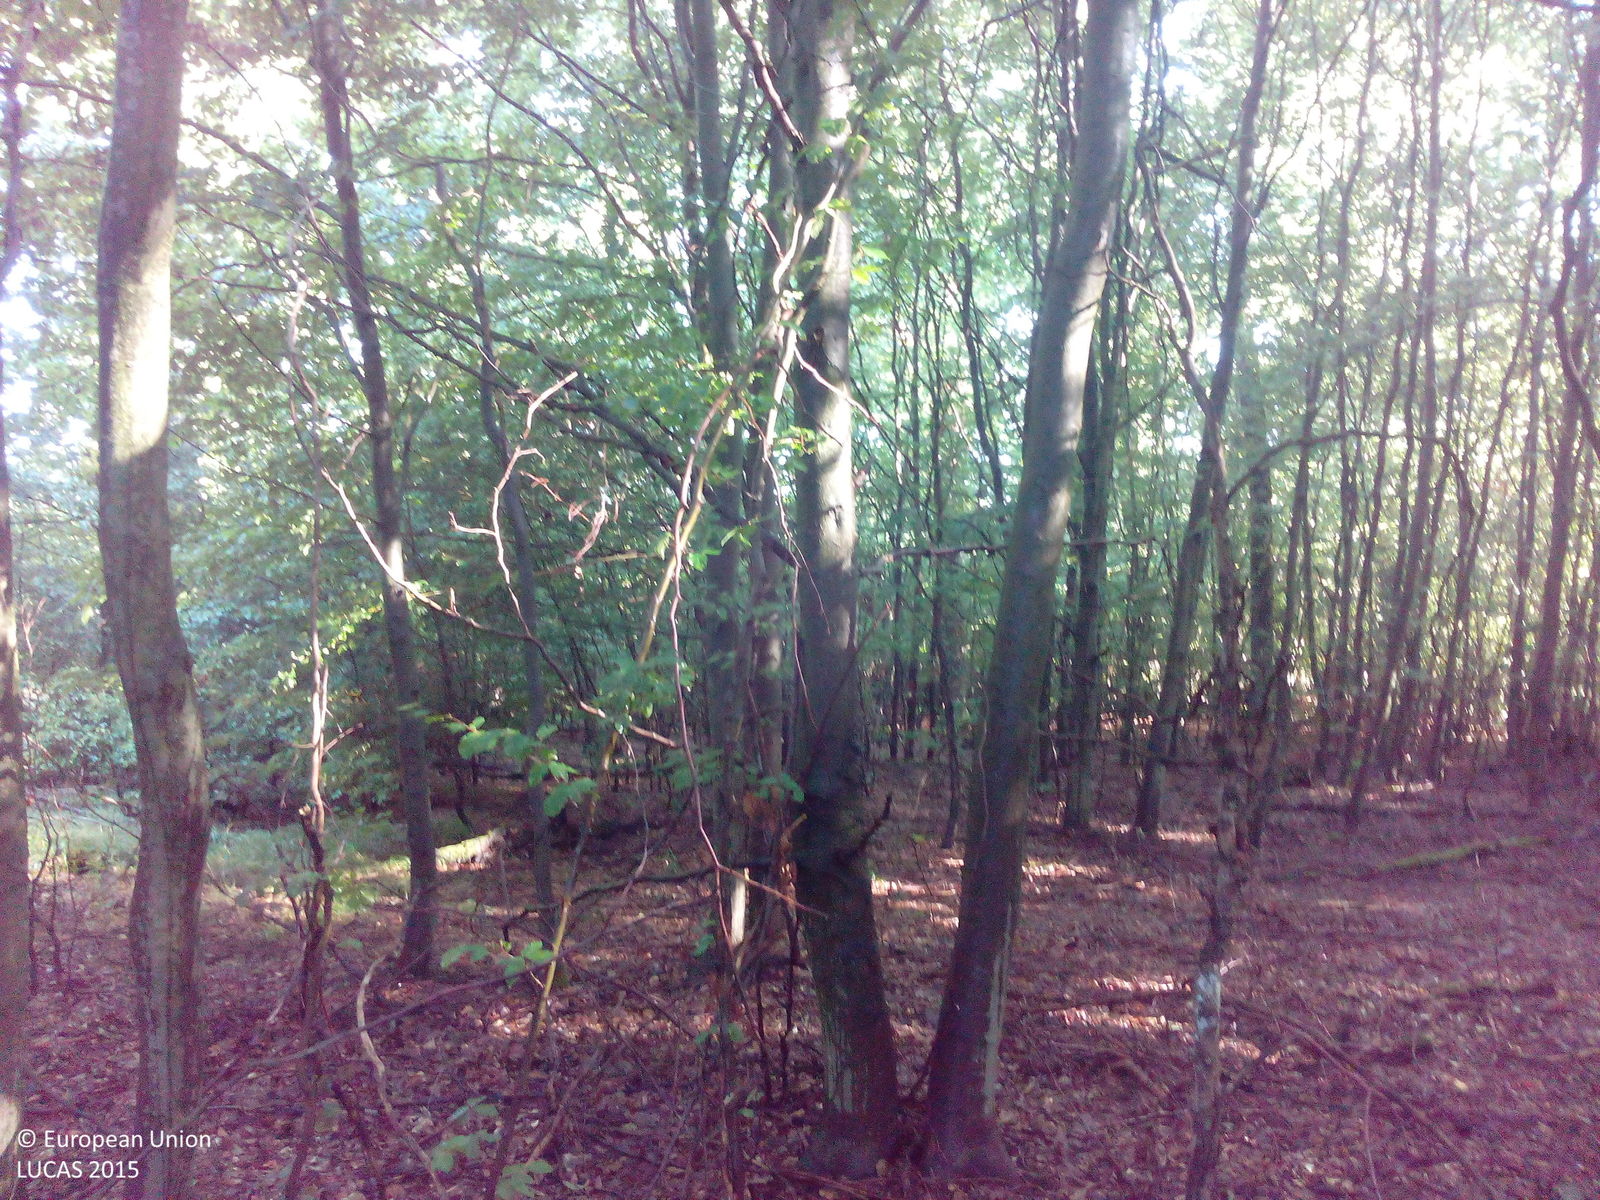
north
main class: Woodland
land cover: Broadleaved woodland
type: beech forest
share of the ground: > 75 %
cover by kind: broadleaved forest trees 100 %
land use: Forestry
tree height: > 5 m
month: August
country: DE
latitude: 51.7086
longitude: 10.9404
